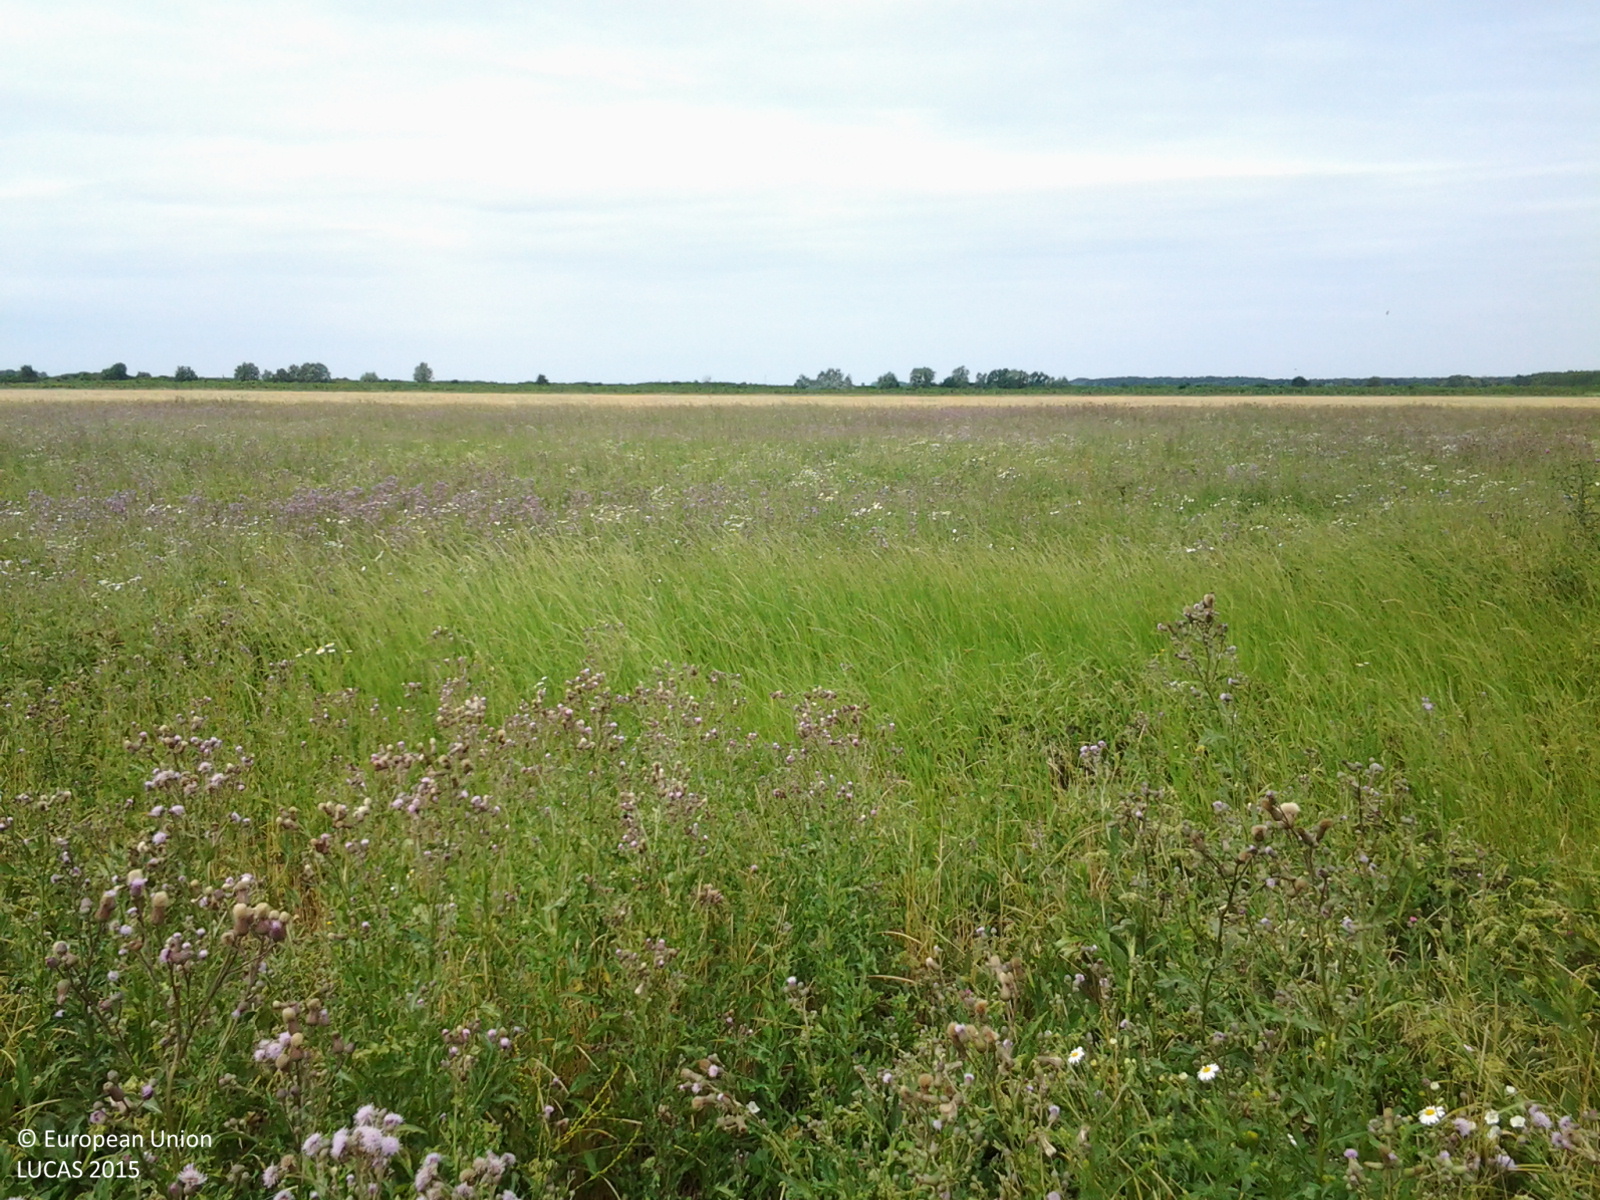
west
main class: Grassland
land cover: Grassland without tree/shrub cover
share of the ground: > 75 %
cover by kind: herbaceous plants 100 %
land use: Agriculture (excluding fallow land and kitchen gardens)
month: June
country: HU
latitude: 46.6317
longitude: 21.3878
